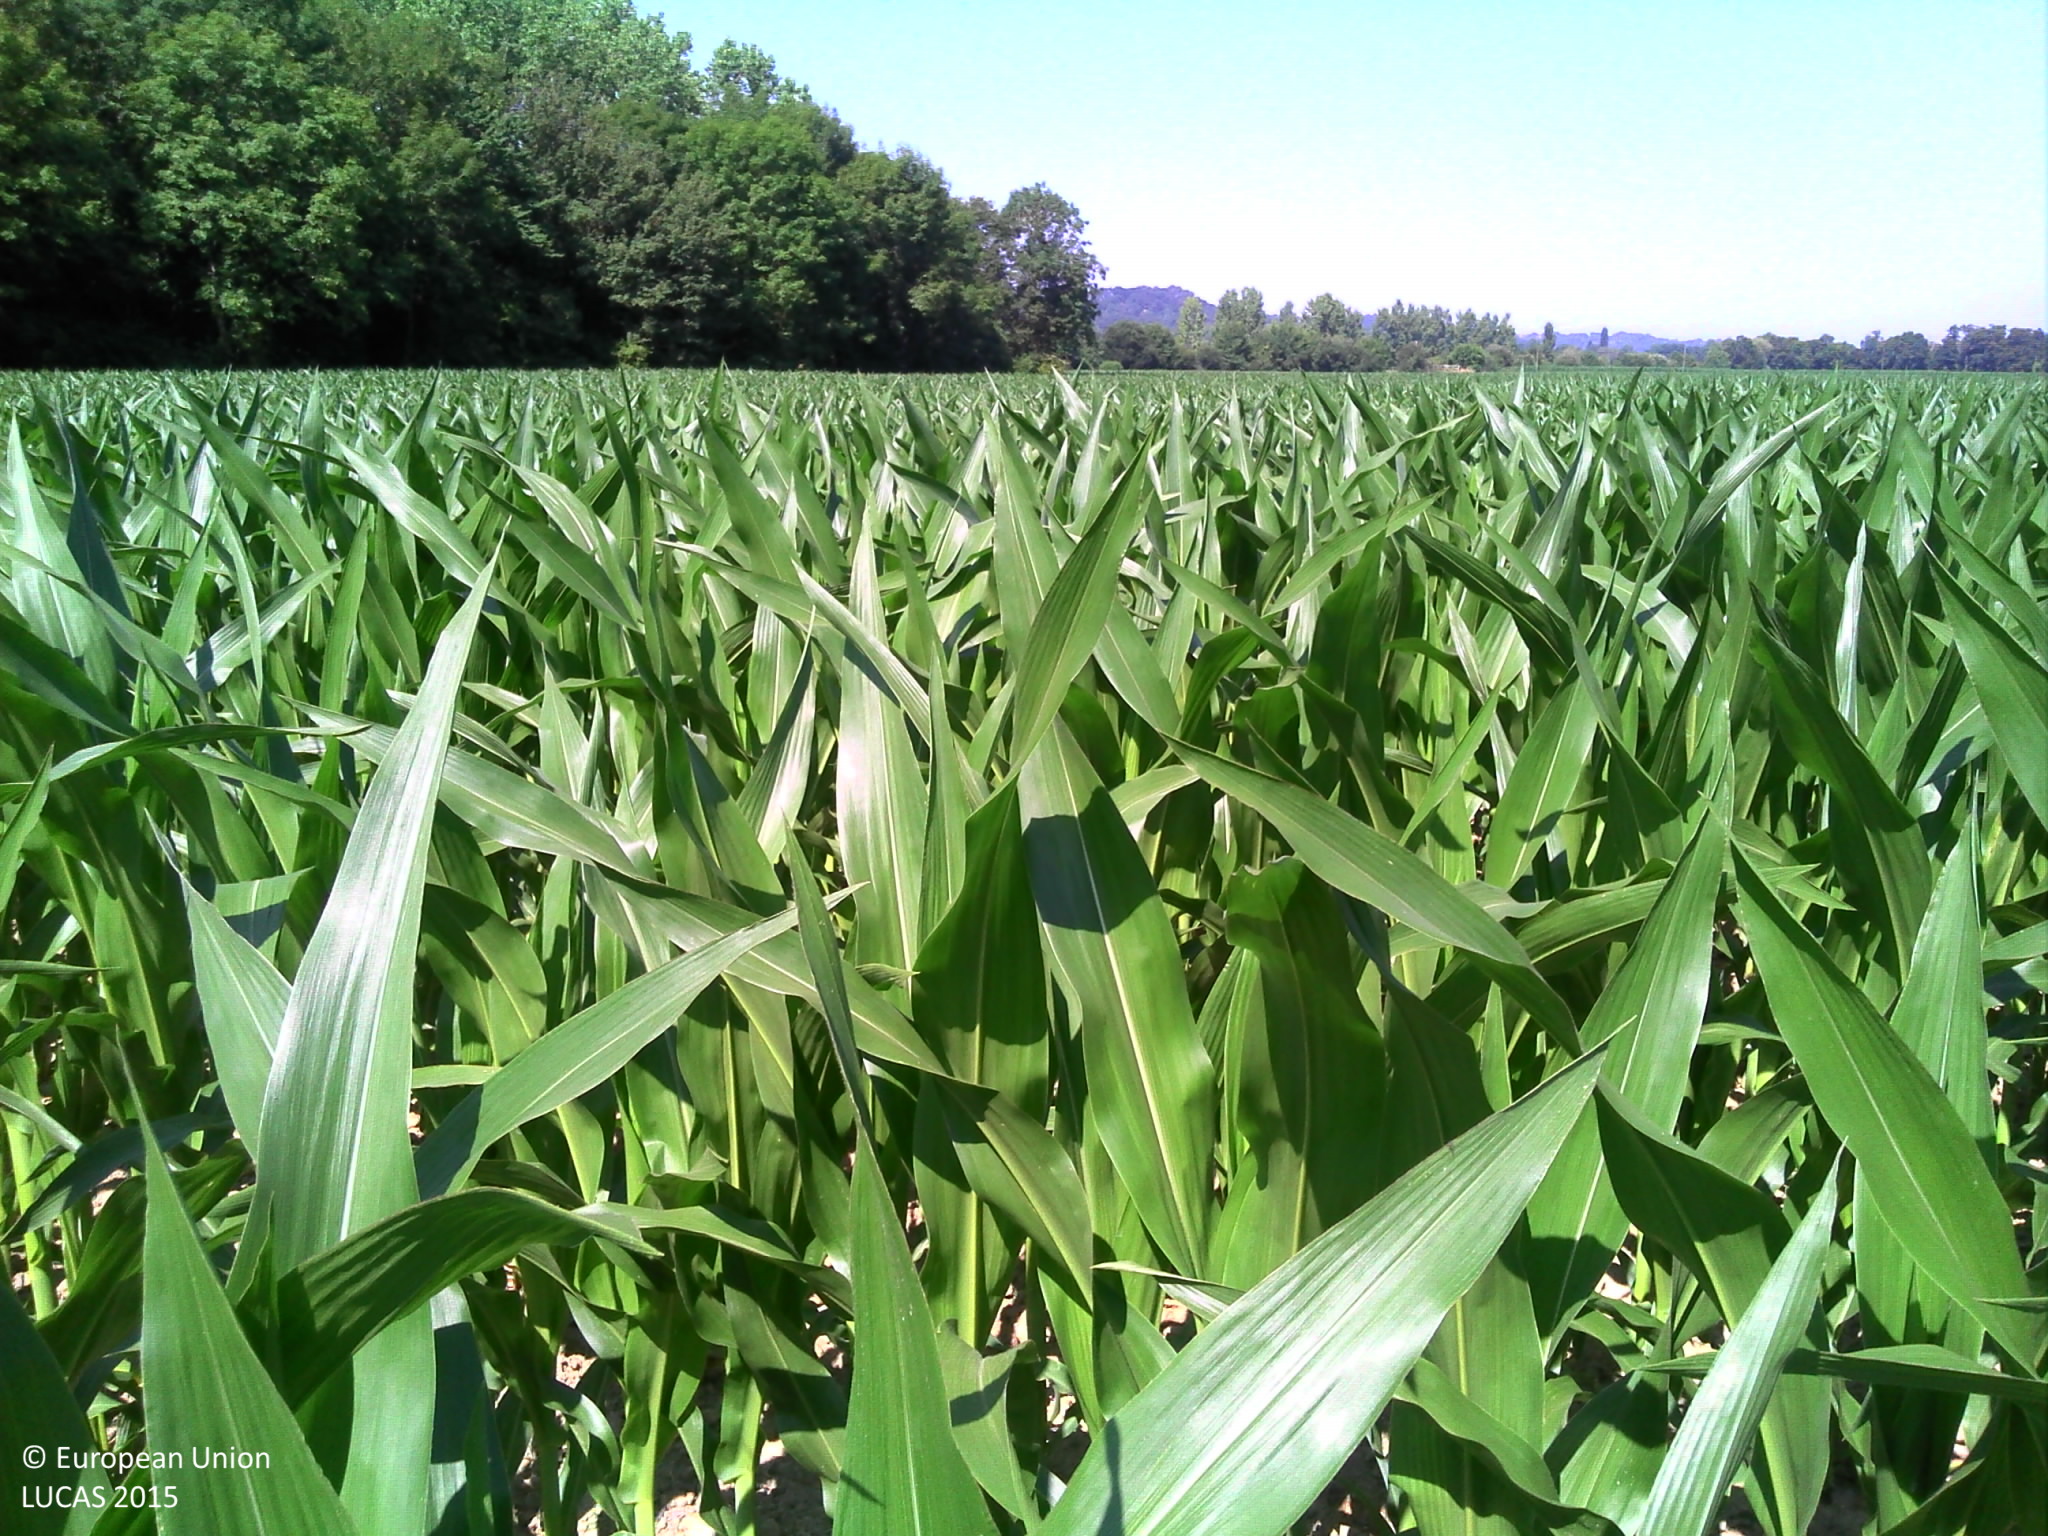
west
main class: Cropland
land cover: Maize
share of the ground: > 75 %
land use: Agriculture (excluding fallow land and kitchen gardens)
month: June
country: FR
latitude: 43.5777
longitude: -0.5234
